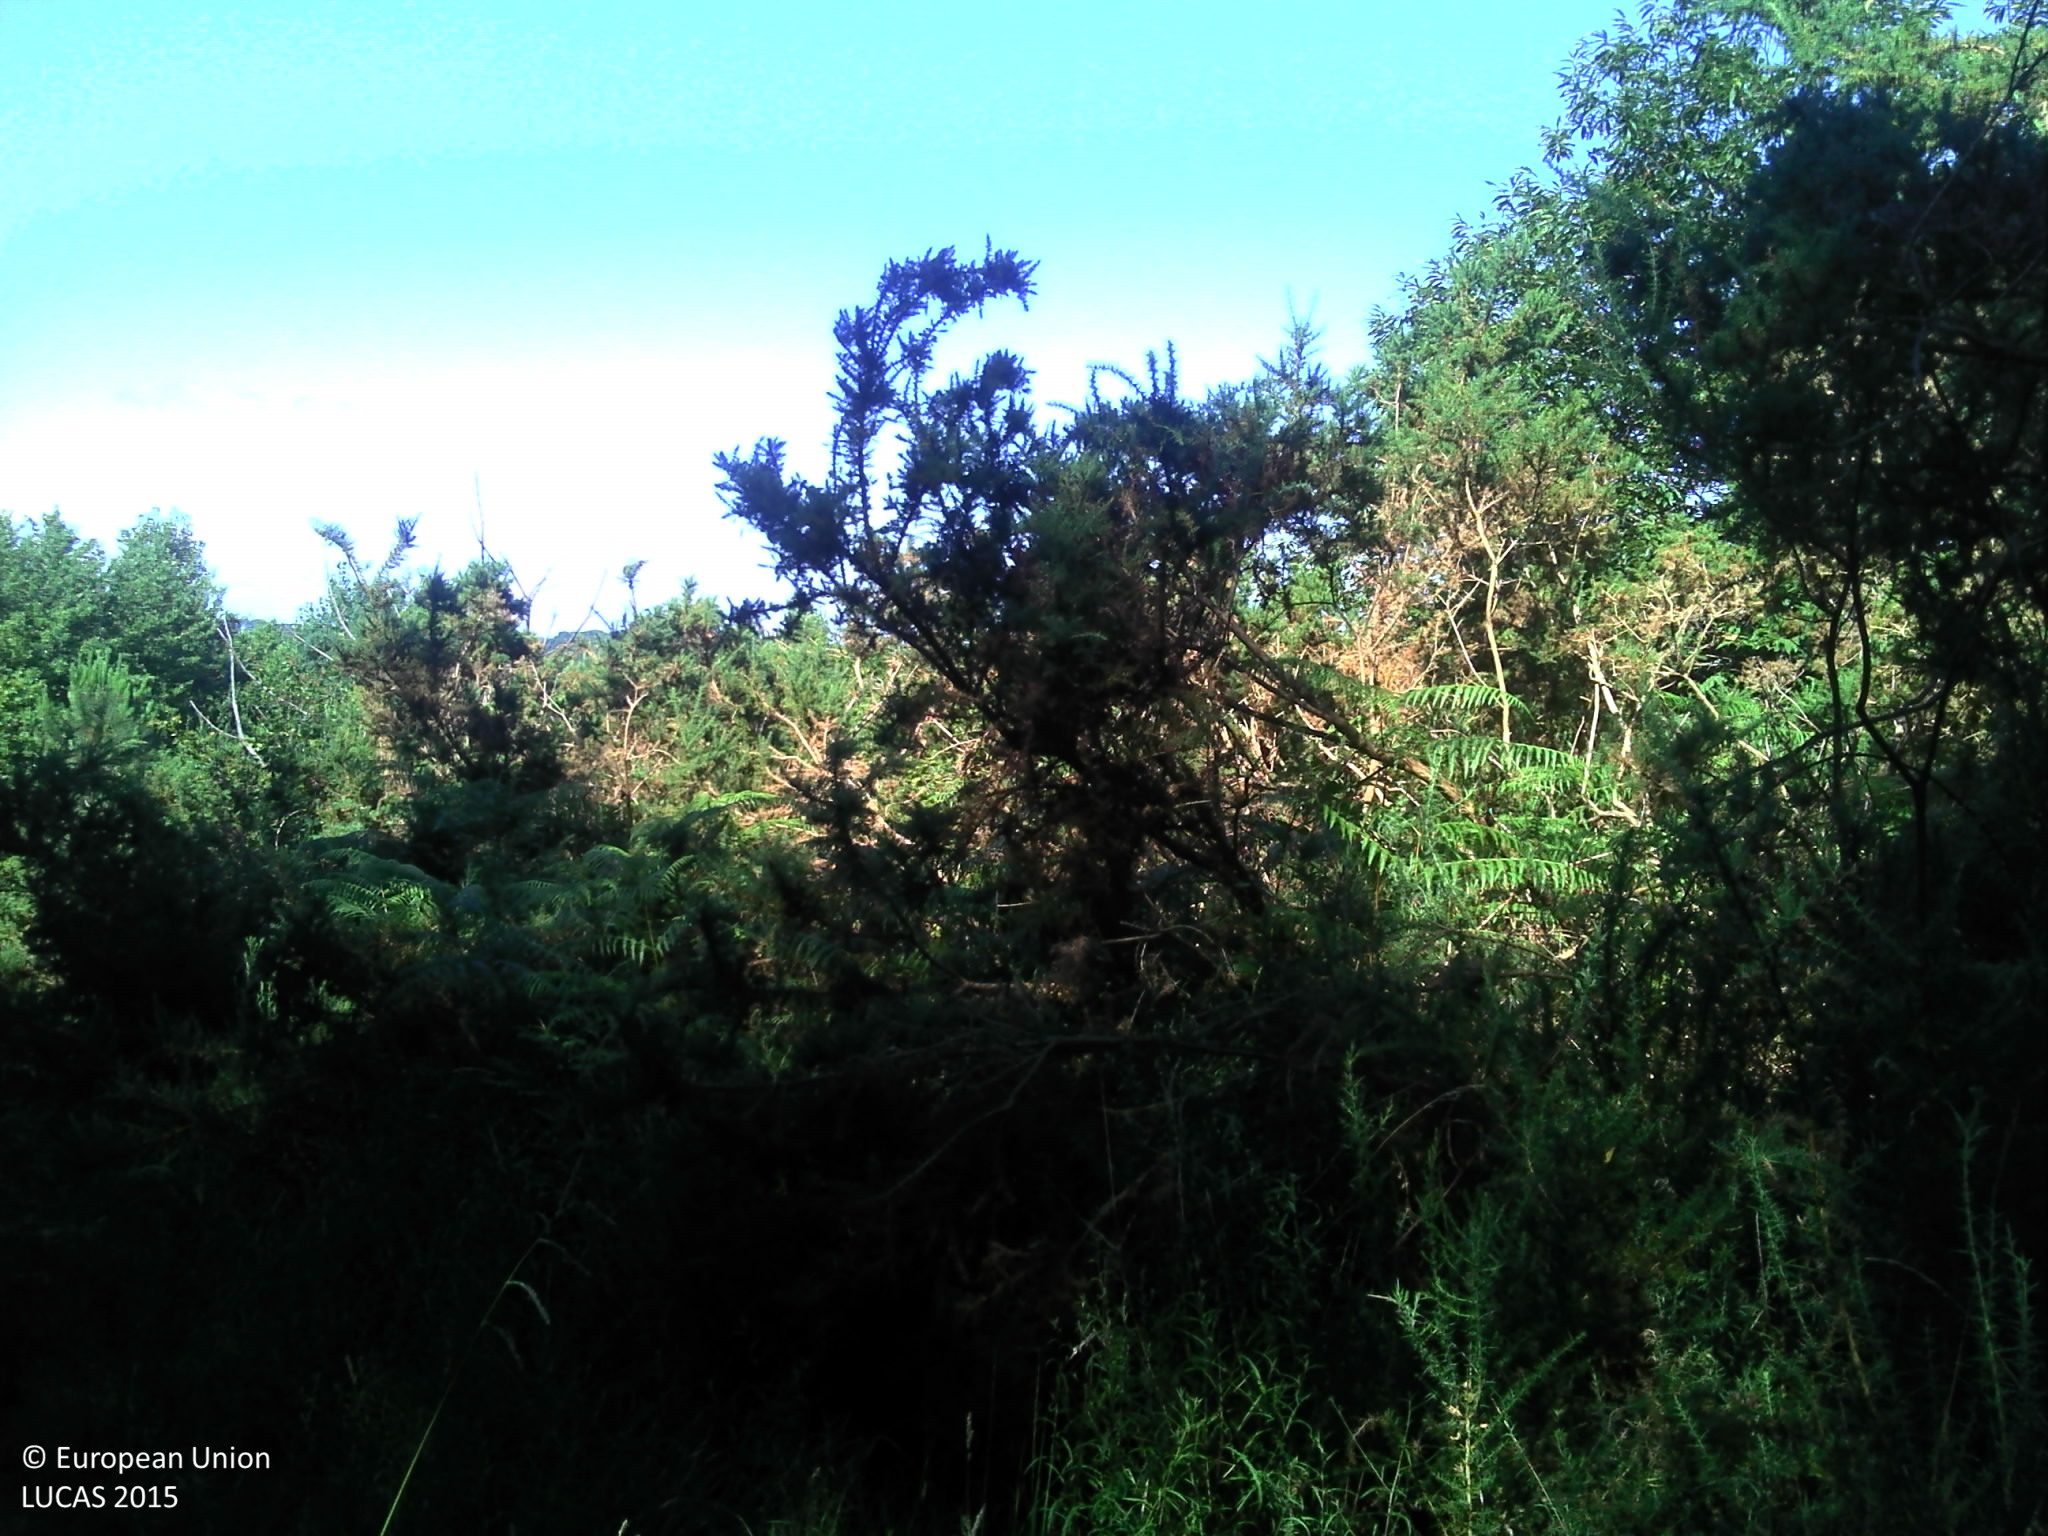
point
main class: Shrubland
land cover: Shrubland with sparse tree cover
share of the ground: > 75 %
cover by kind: shrubs 60 %, herbaceous plants 35 %, broadleaved forest trees 5 %
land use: Semi-natural and natural areas not in use
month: July
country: FR
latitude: 43.5893
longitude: -1.1005
